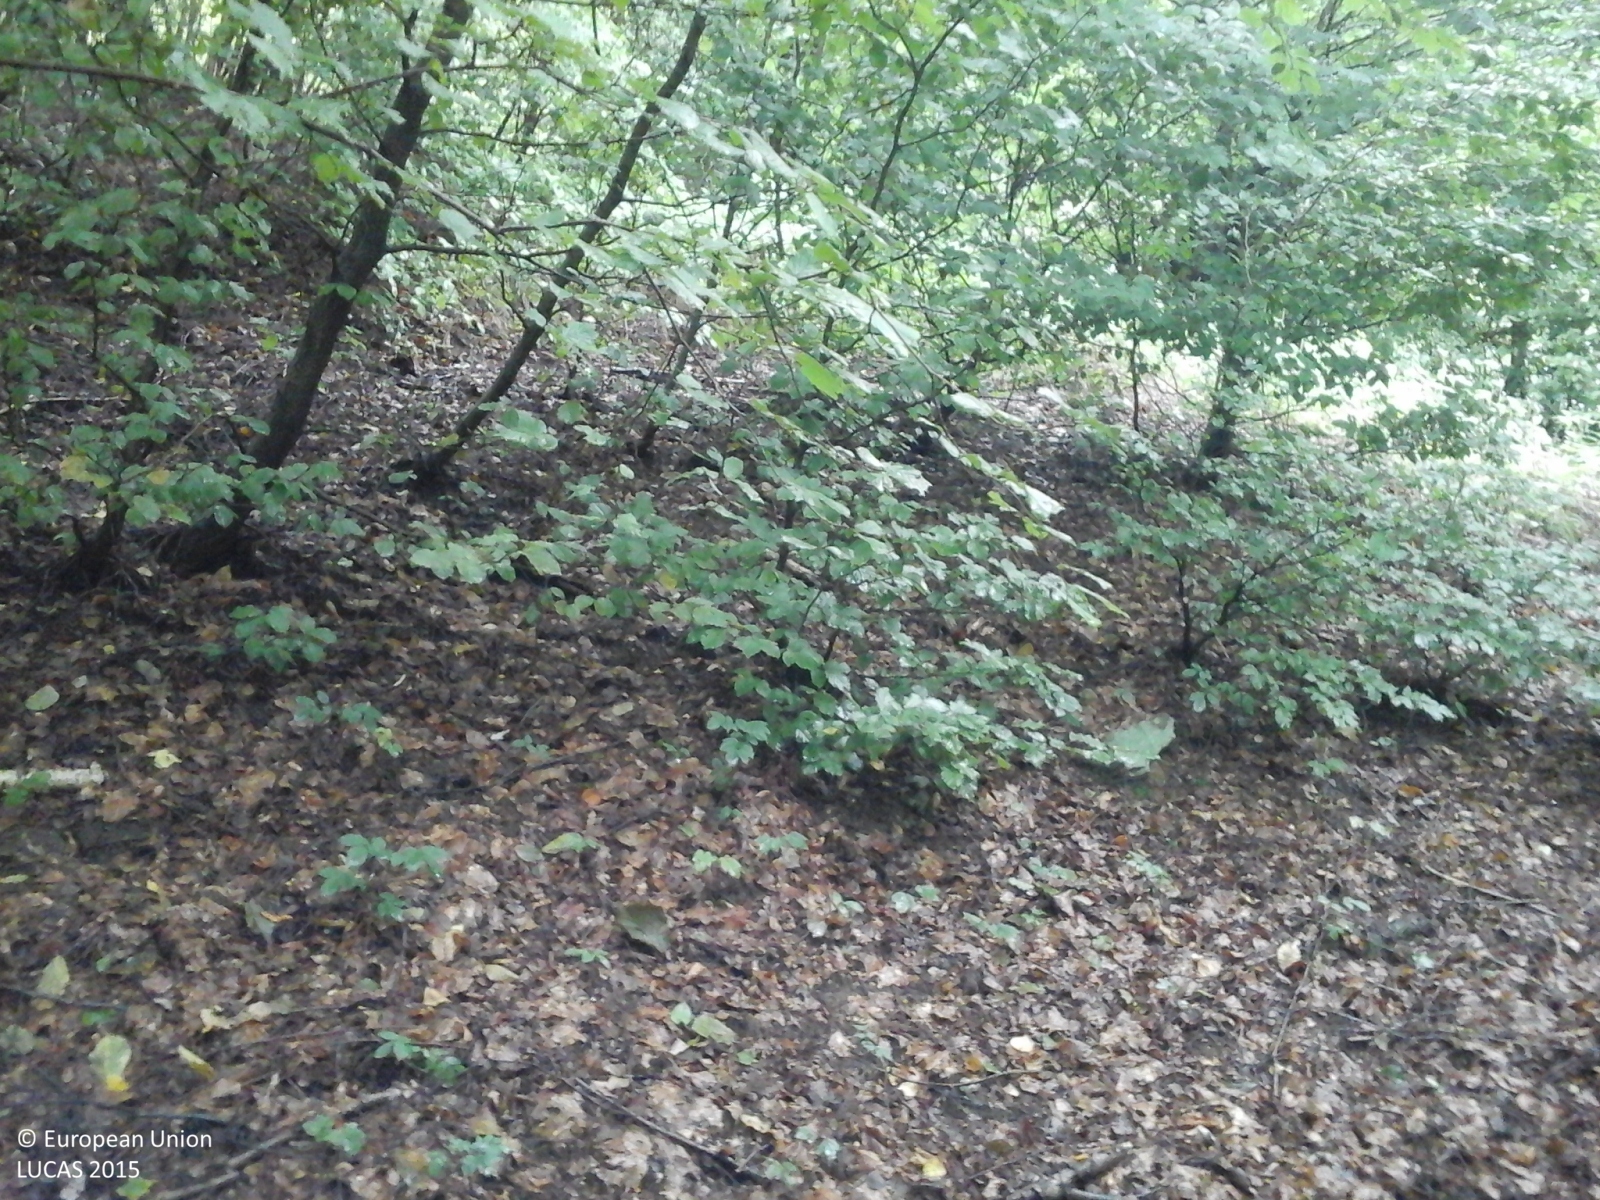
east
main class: Woodland
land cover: Broadleaved woodland
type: mountainous beech forest
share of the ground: > 75 %
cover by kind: broadleaved forest trees 75 %, herbaceous plants 20 %, consolidated bare surface 5 %
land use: Forestry
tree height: > 5 m
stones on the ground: 10 - 25 %
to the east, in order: Broadleaved woodland; Tracks; Broadleaved woodland
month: August
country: IT
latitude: 45.9151
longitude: 9.1117
